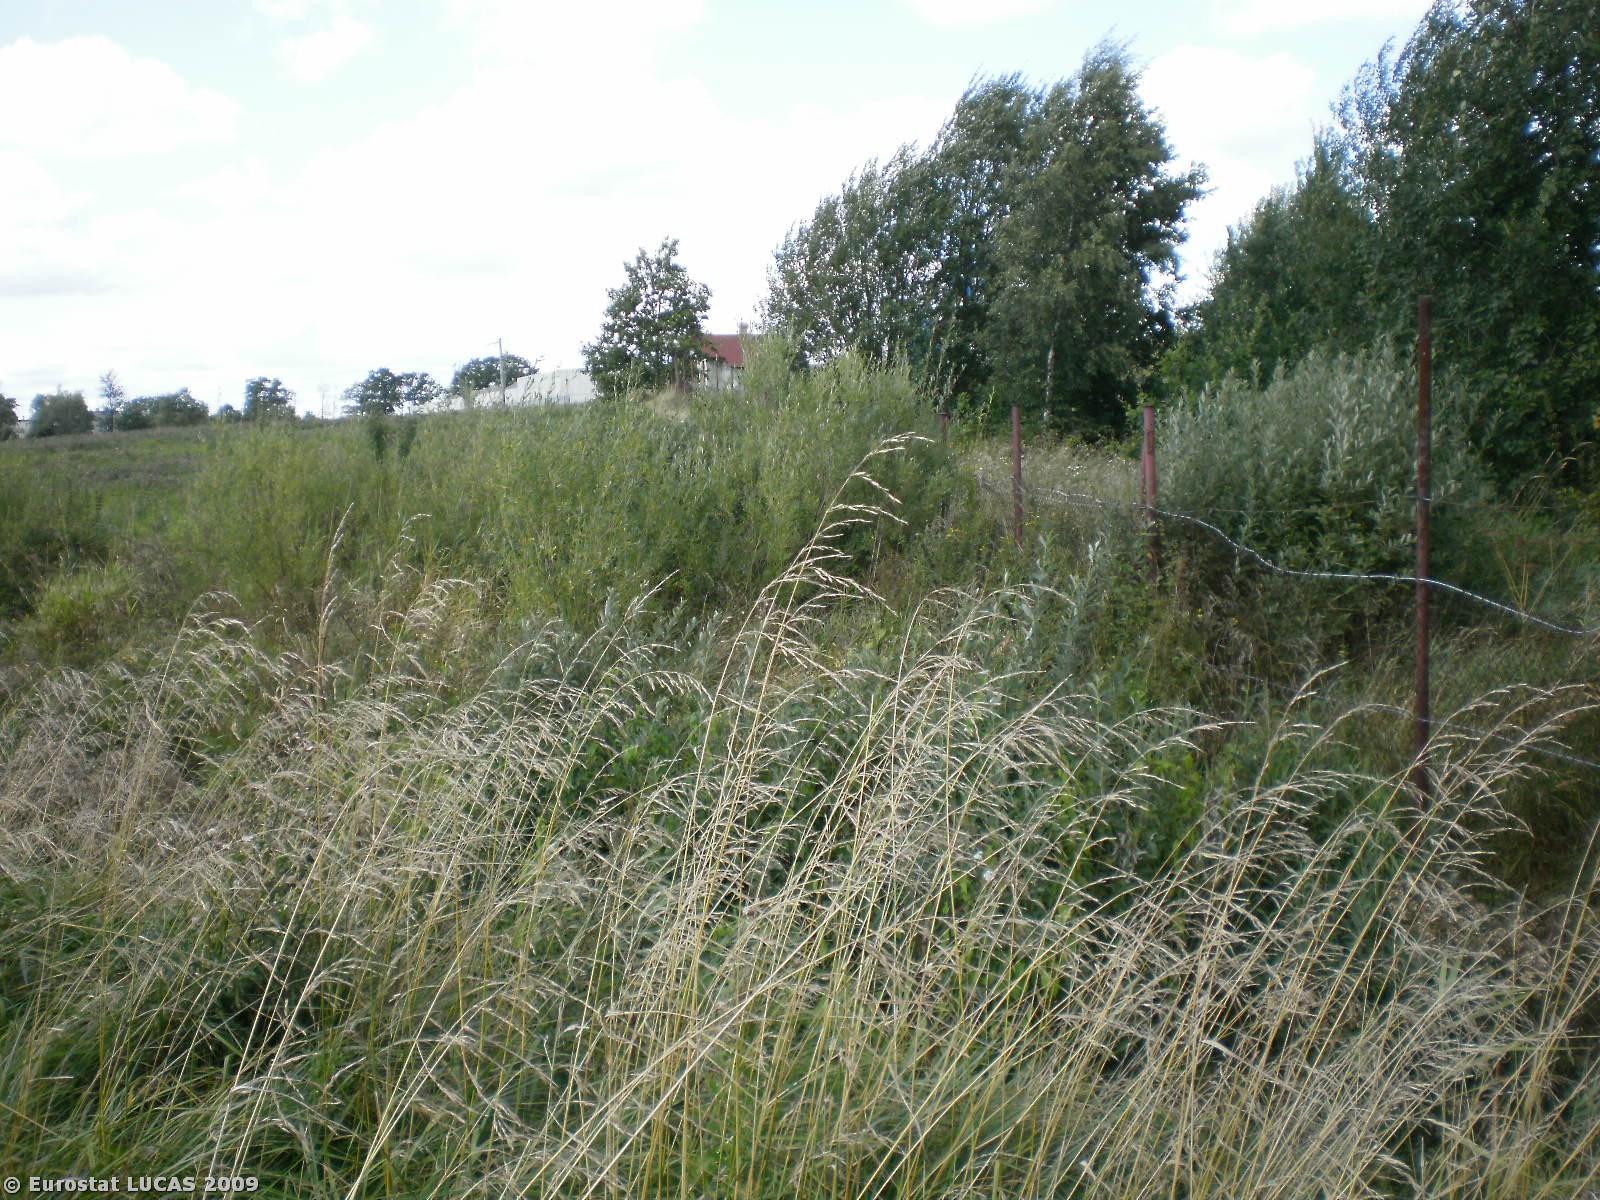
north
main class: Cropland
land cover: Triticale
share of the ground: < 10 %
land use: Agriculture (excluding fallow land and kitchen gardens)
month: September
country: PL
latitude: 54.3706
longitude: 18.4675
